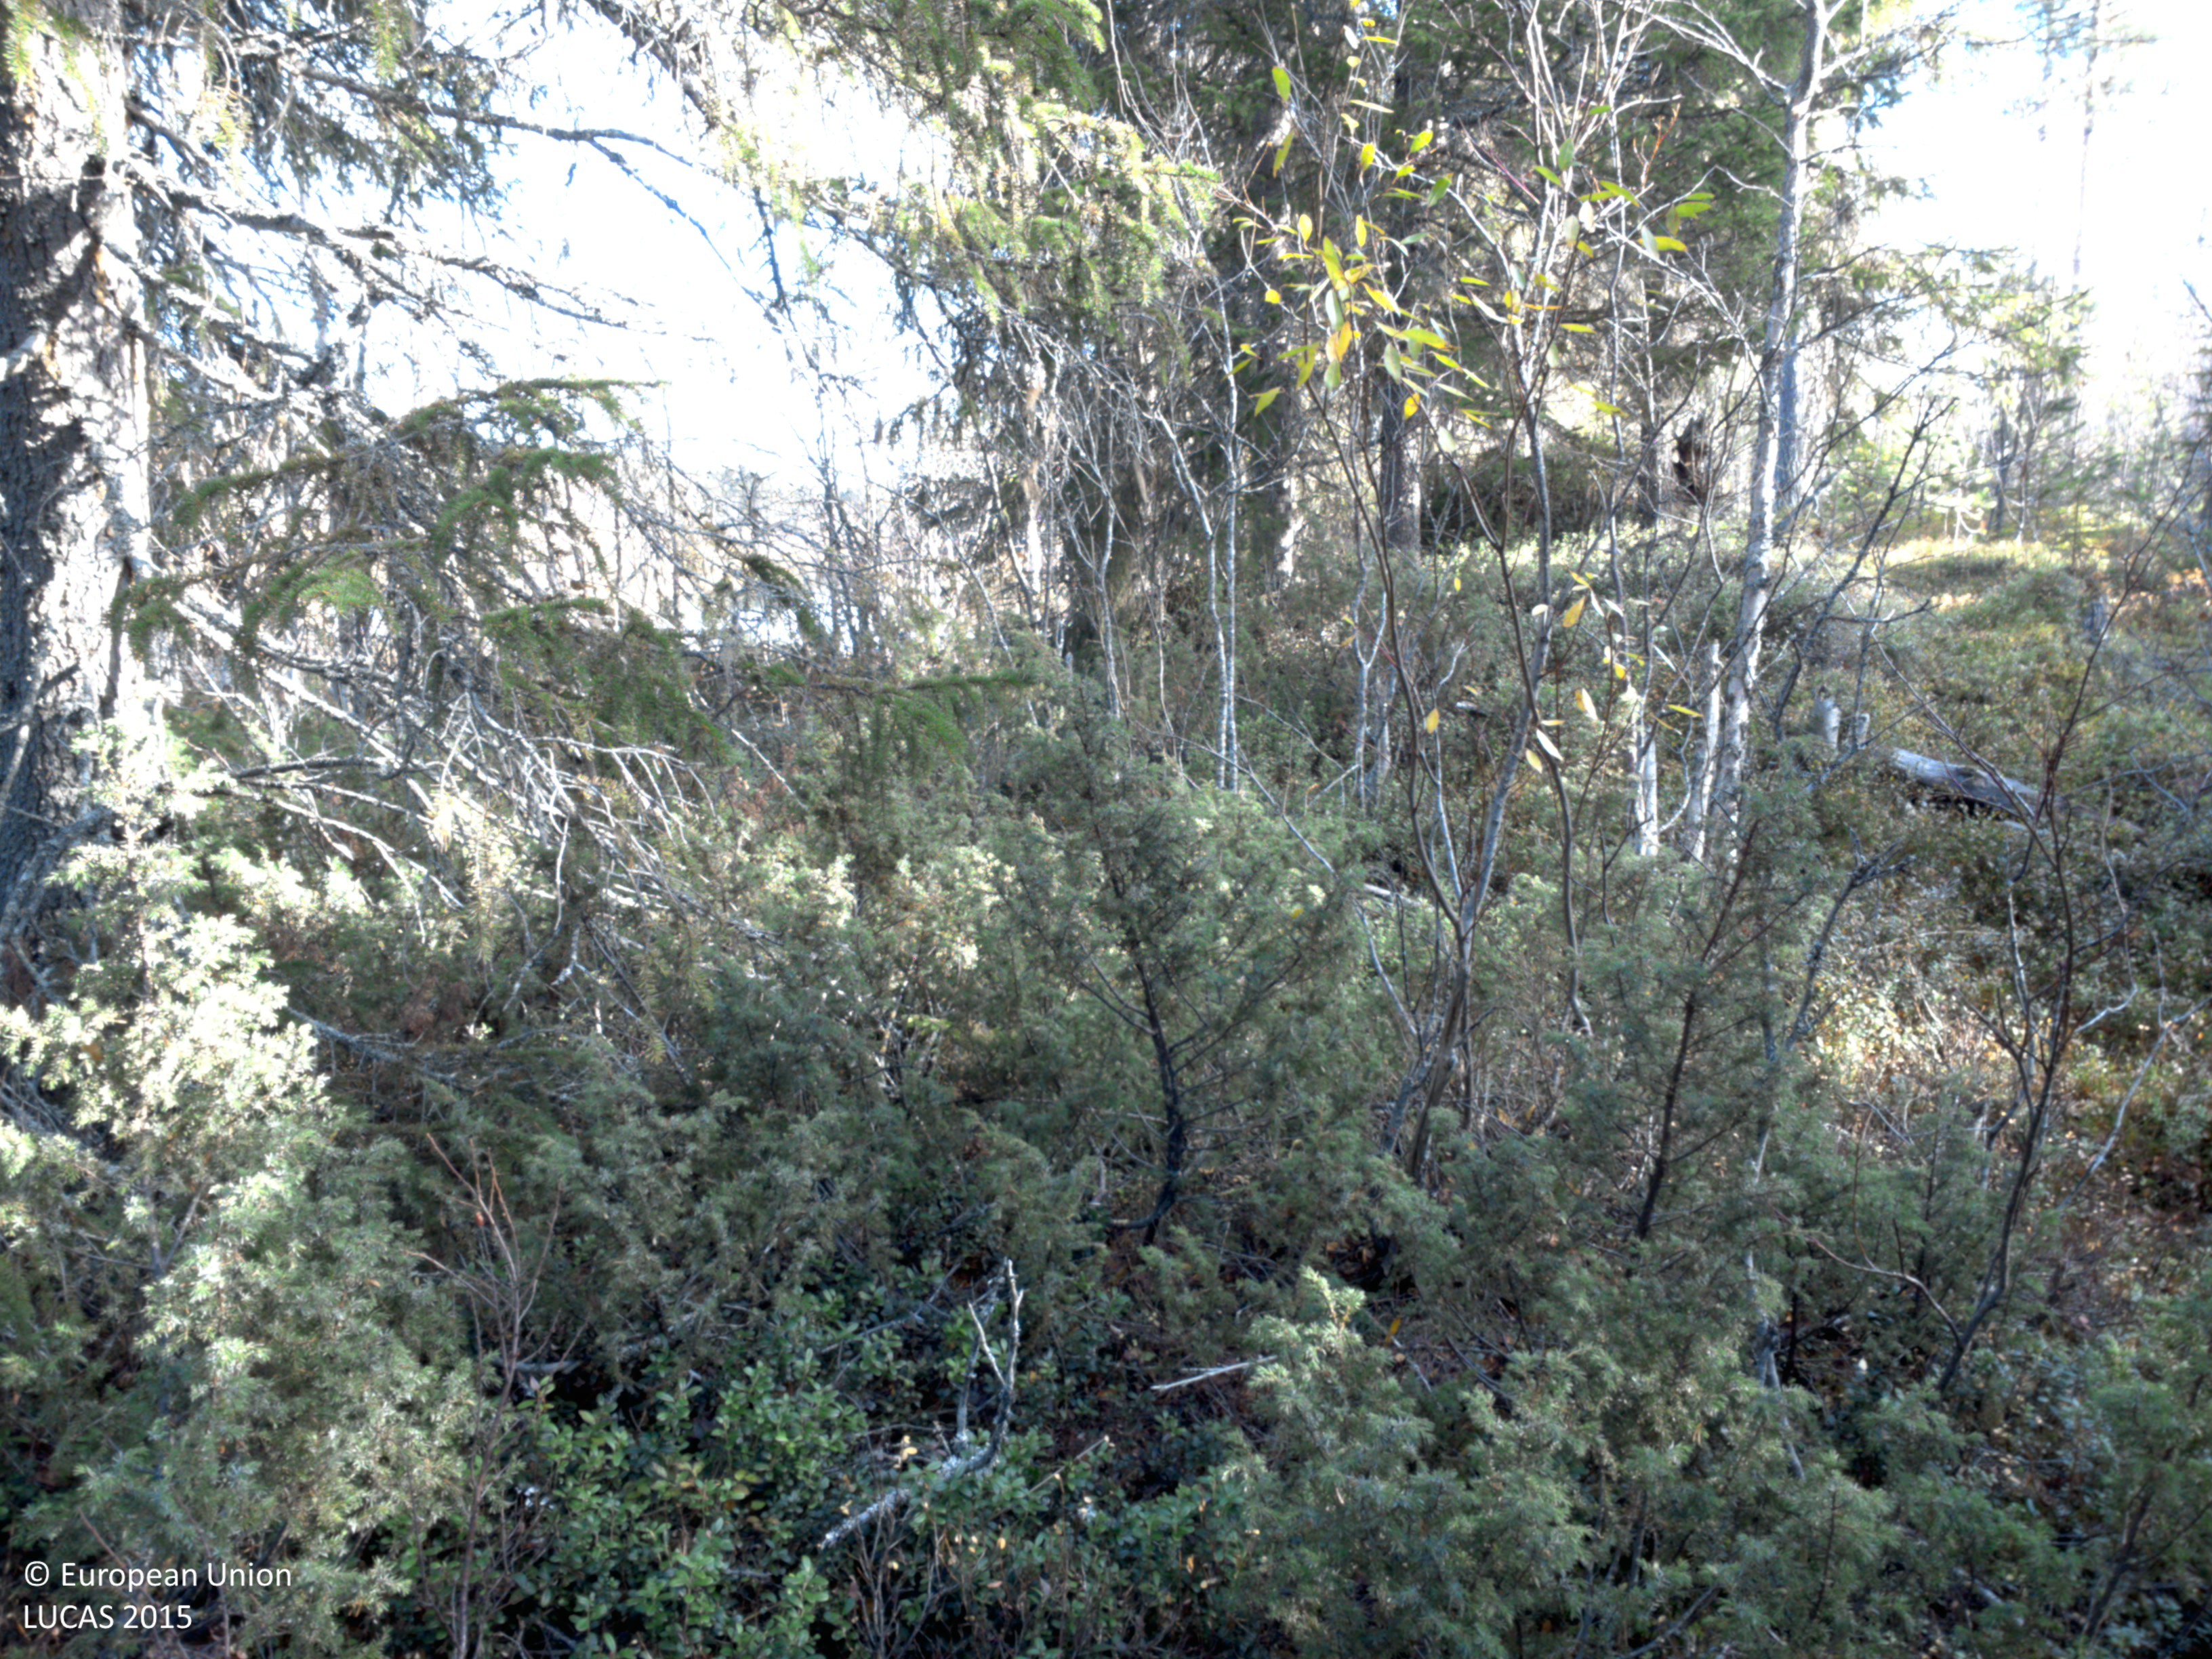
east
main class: Woodland
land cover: Other mixed woodland
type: boreal forest
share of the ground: 50 - 75 %
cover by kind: coniferous forest trees 45 %, shrubs 35 %, broadleaved forest trees 15 %, herbaceous plants 5 %
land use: Forestry
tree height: > 5 m
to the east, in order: Other mixed woodland; Spruce dominated mixed woodland; Inland fresh running water; Spruce dominated mixed woodland; Pine dominated mixed woodland; Spruce dominated mixed woodland
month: October
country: SE
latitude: 64.6312
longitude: 18.0203
